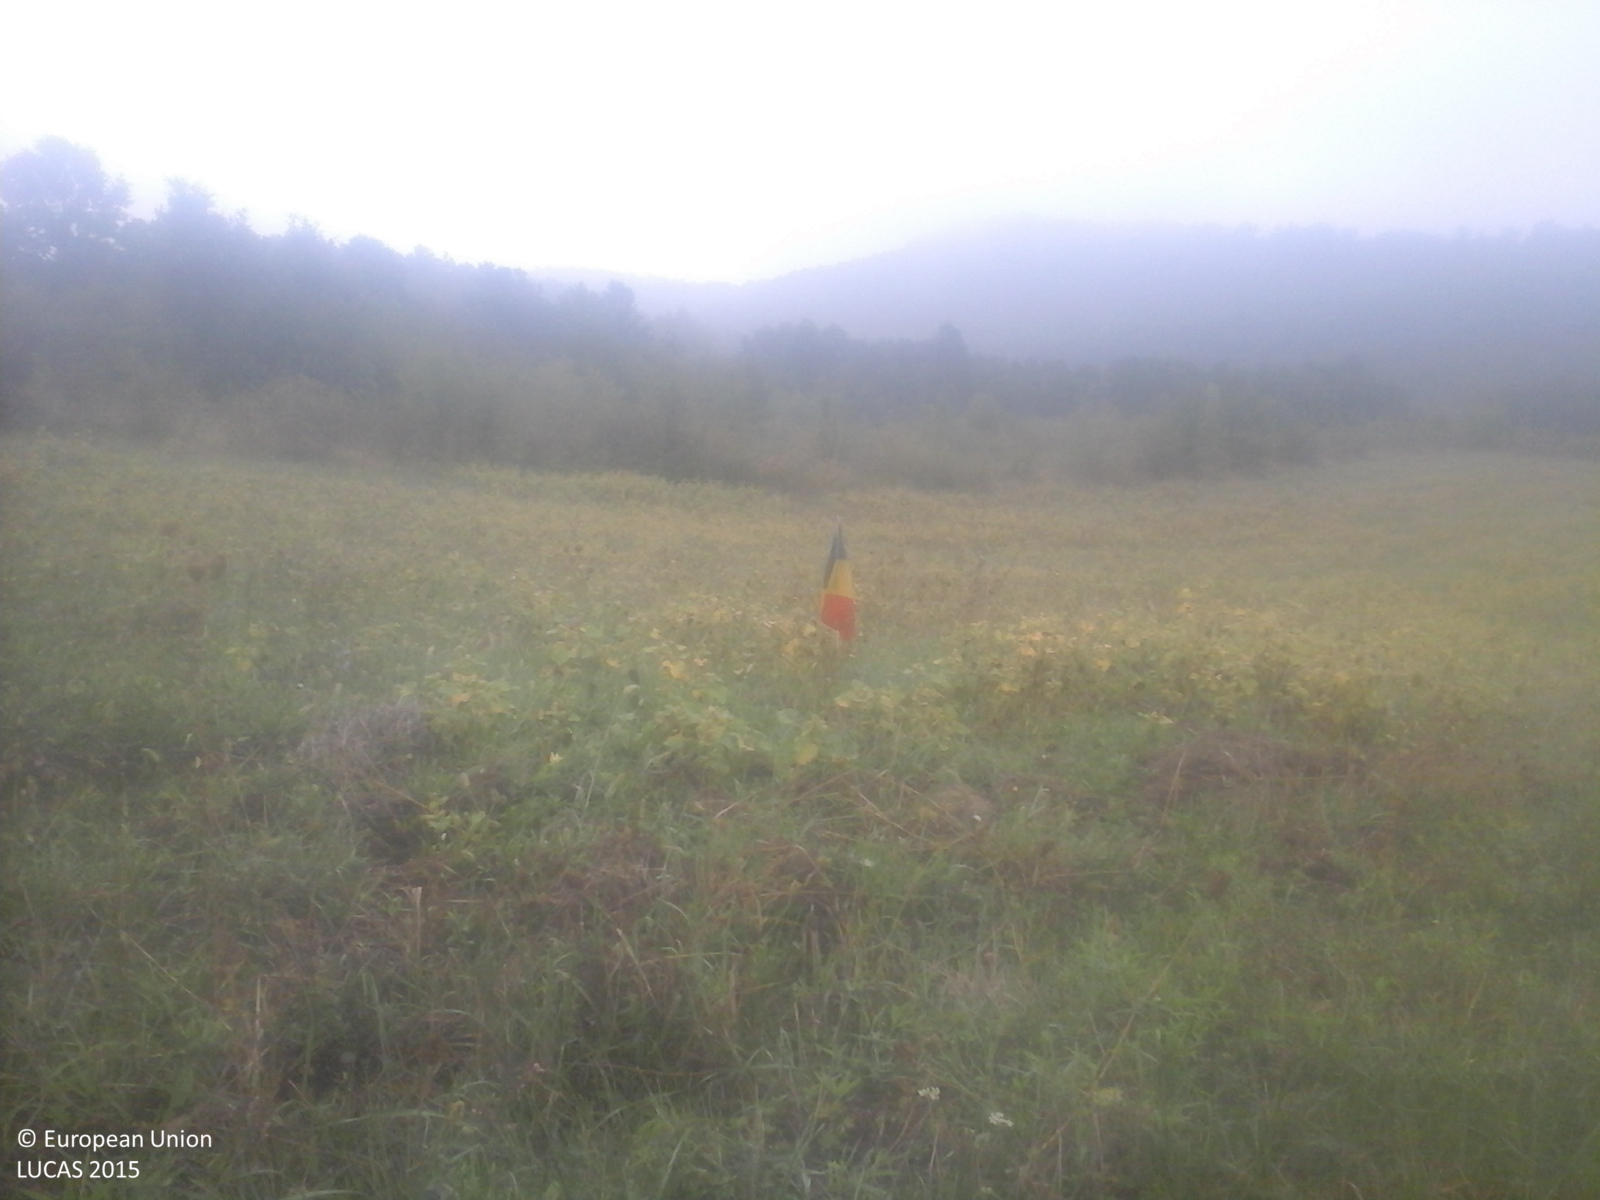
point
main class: Grassland
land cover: Spontaneously vegetated surfaces
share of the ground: > 75 %
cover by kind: herbaceous plants 100 %
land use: Agriculture (excluding fallow land and kitchen gardens)
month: September
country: RO
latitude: 44.8395
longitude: 23.1694
